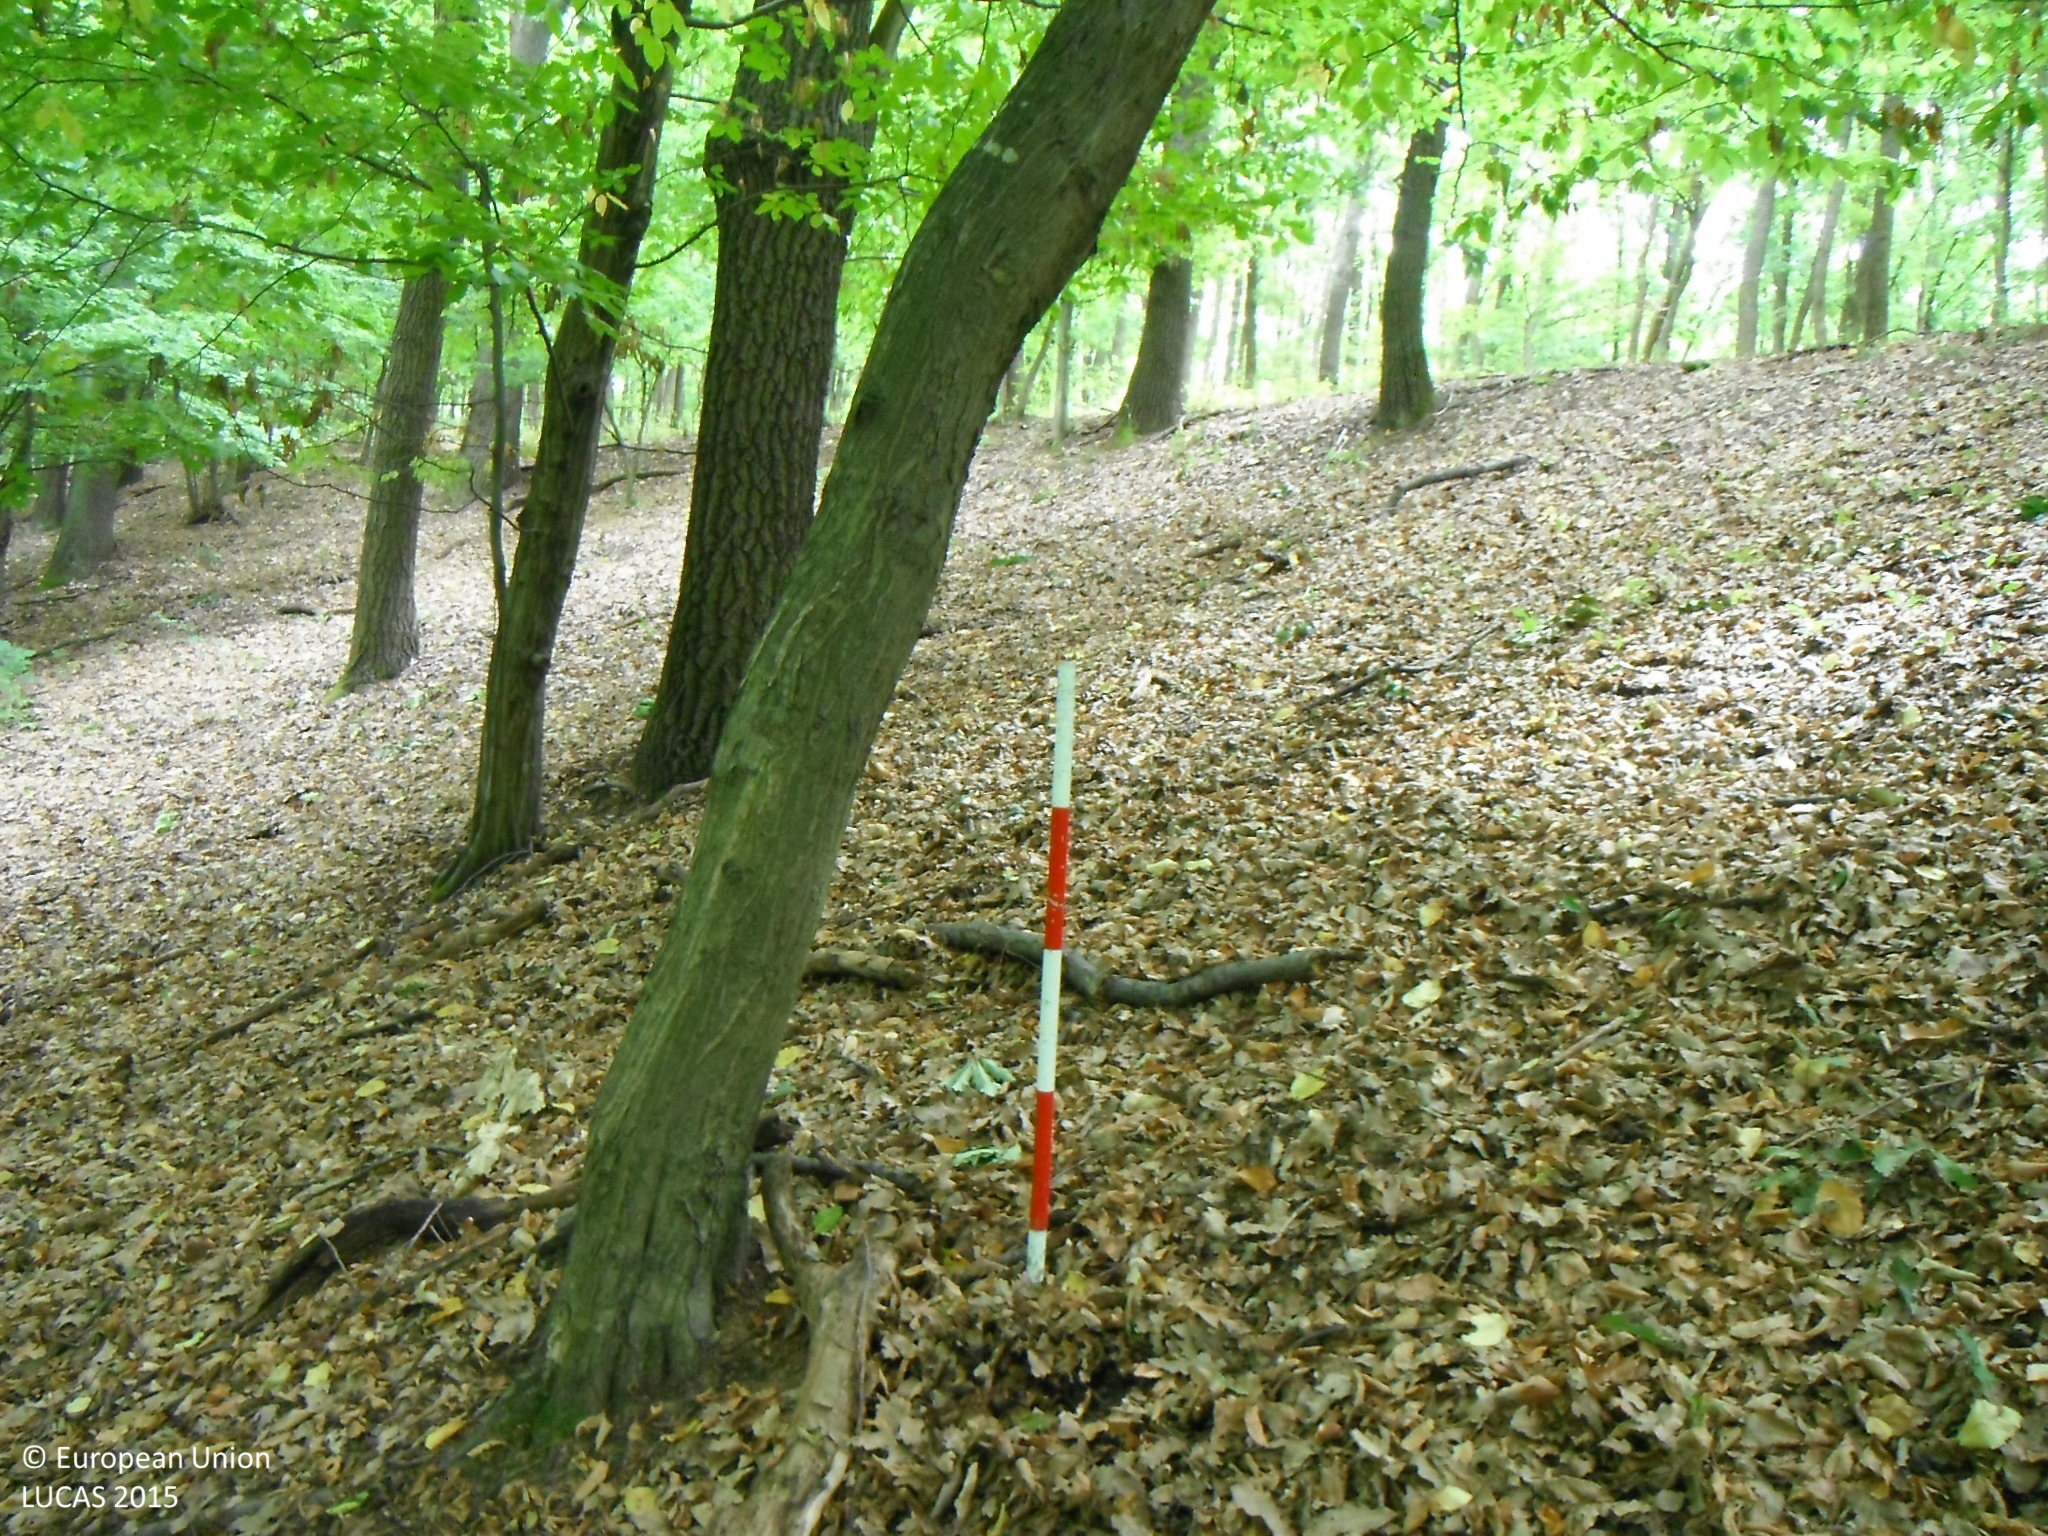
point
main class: Woodland
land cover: Broadleaved woodland
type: mesophytic deciduous forest
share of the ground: > 75 %
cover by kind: broadleaved forest trees 100 %
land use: Forestry
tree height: > 5 m
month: July
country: SK
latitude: 48.1972
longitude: 19.8620
